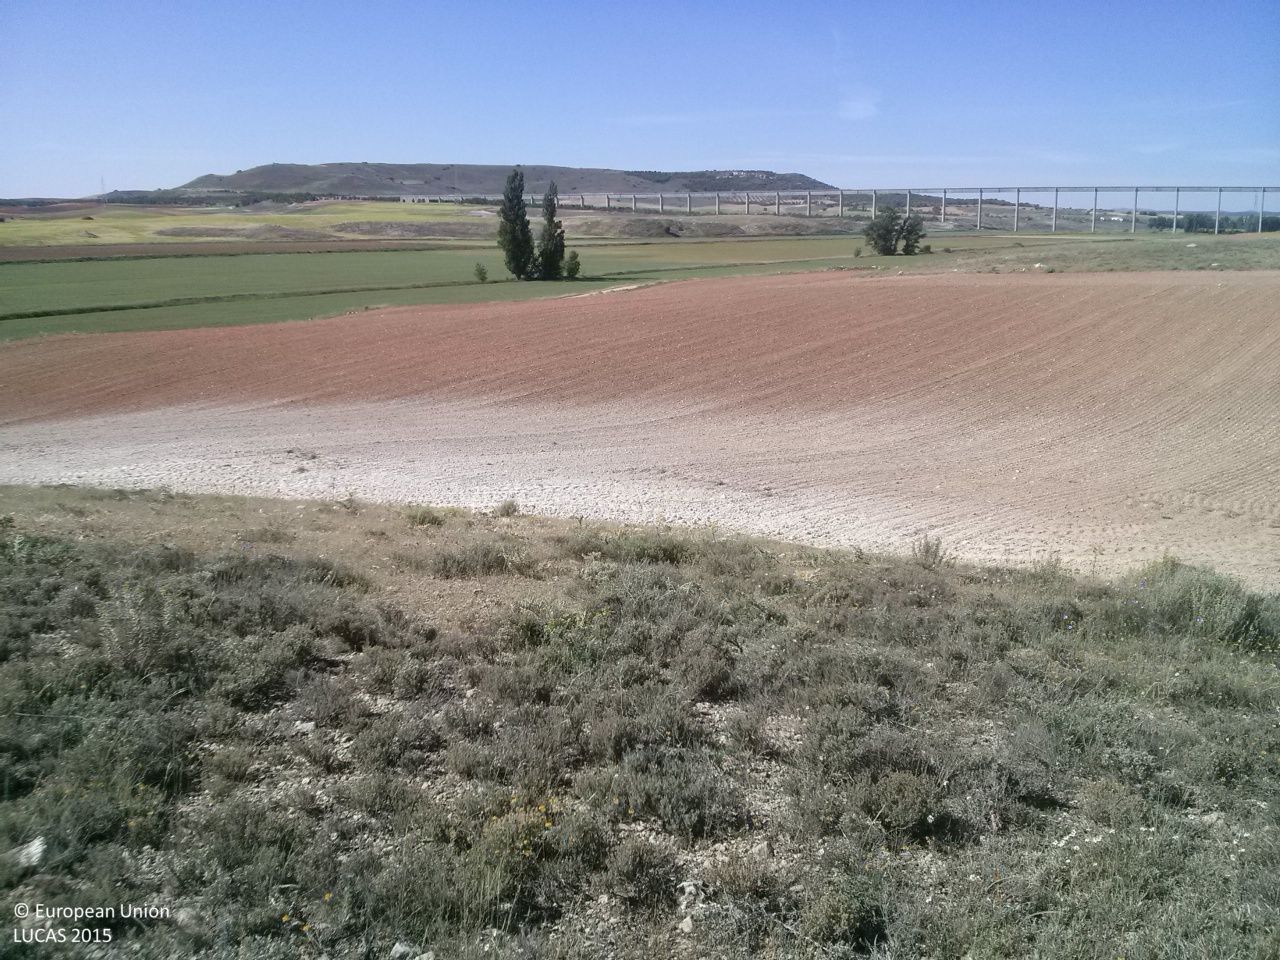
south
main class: Shrubland
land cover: Shrubland without tree cover
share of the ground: 50 - 75 %
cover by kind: shrubs 50 %, herbaceous plants 30 %, unconsolidated bare surface 20 %
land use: Semi-natural and natural areas not in use
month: May
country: ES
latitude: 39.9362
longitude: -2.6696
